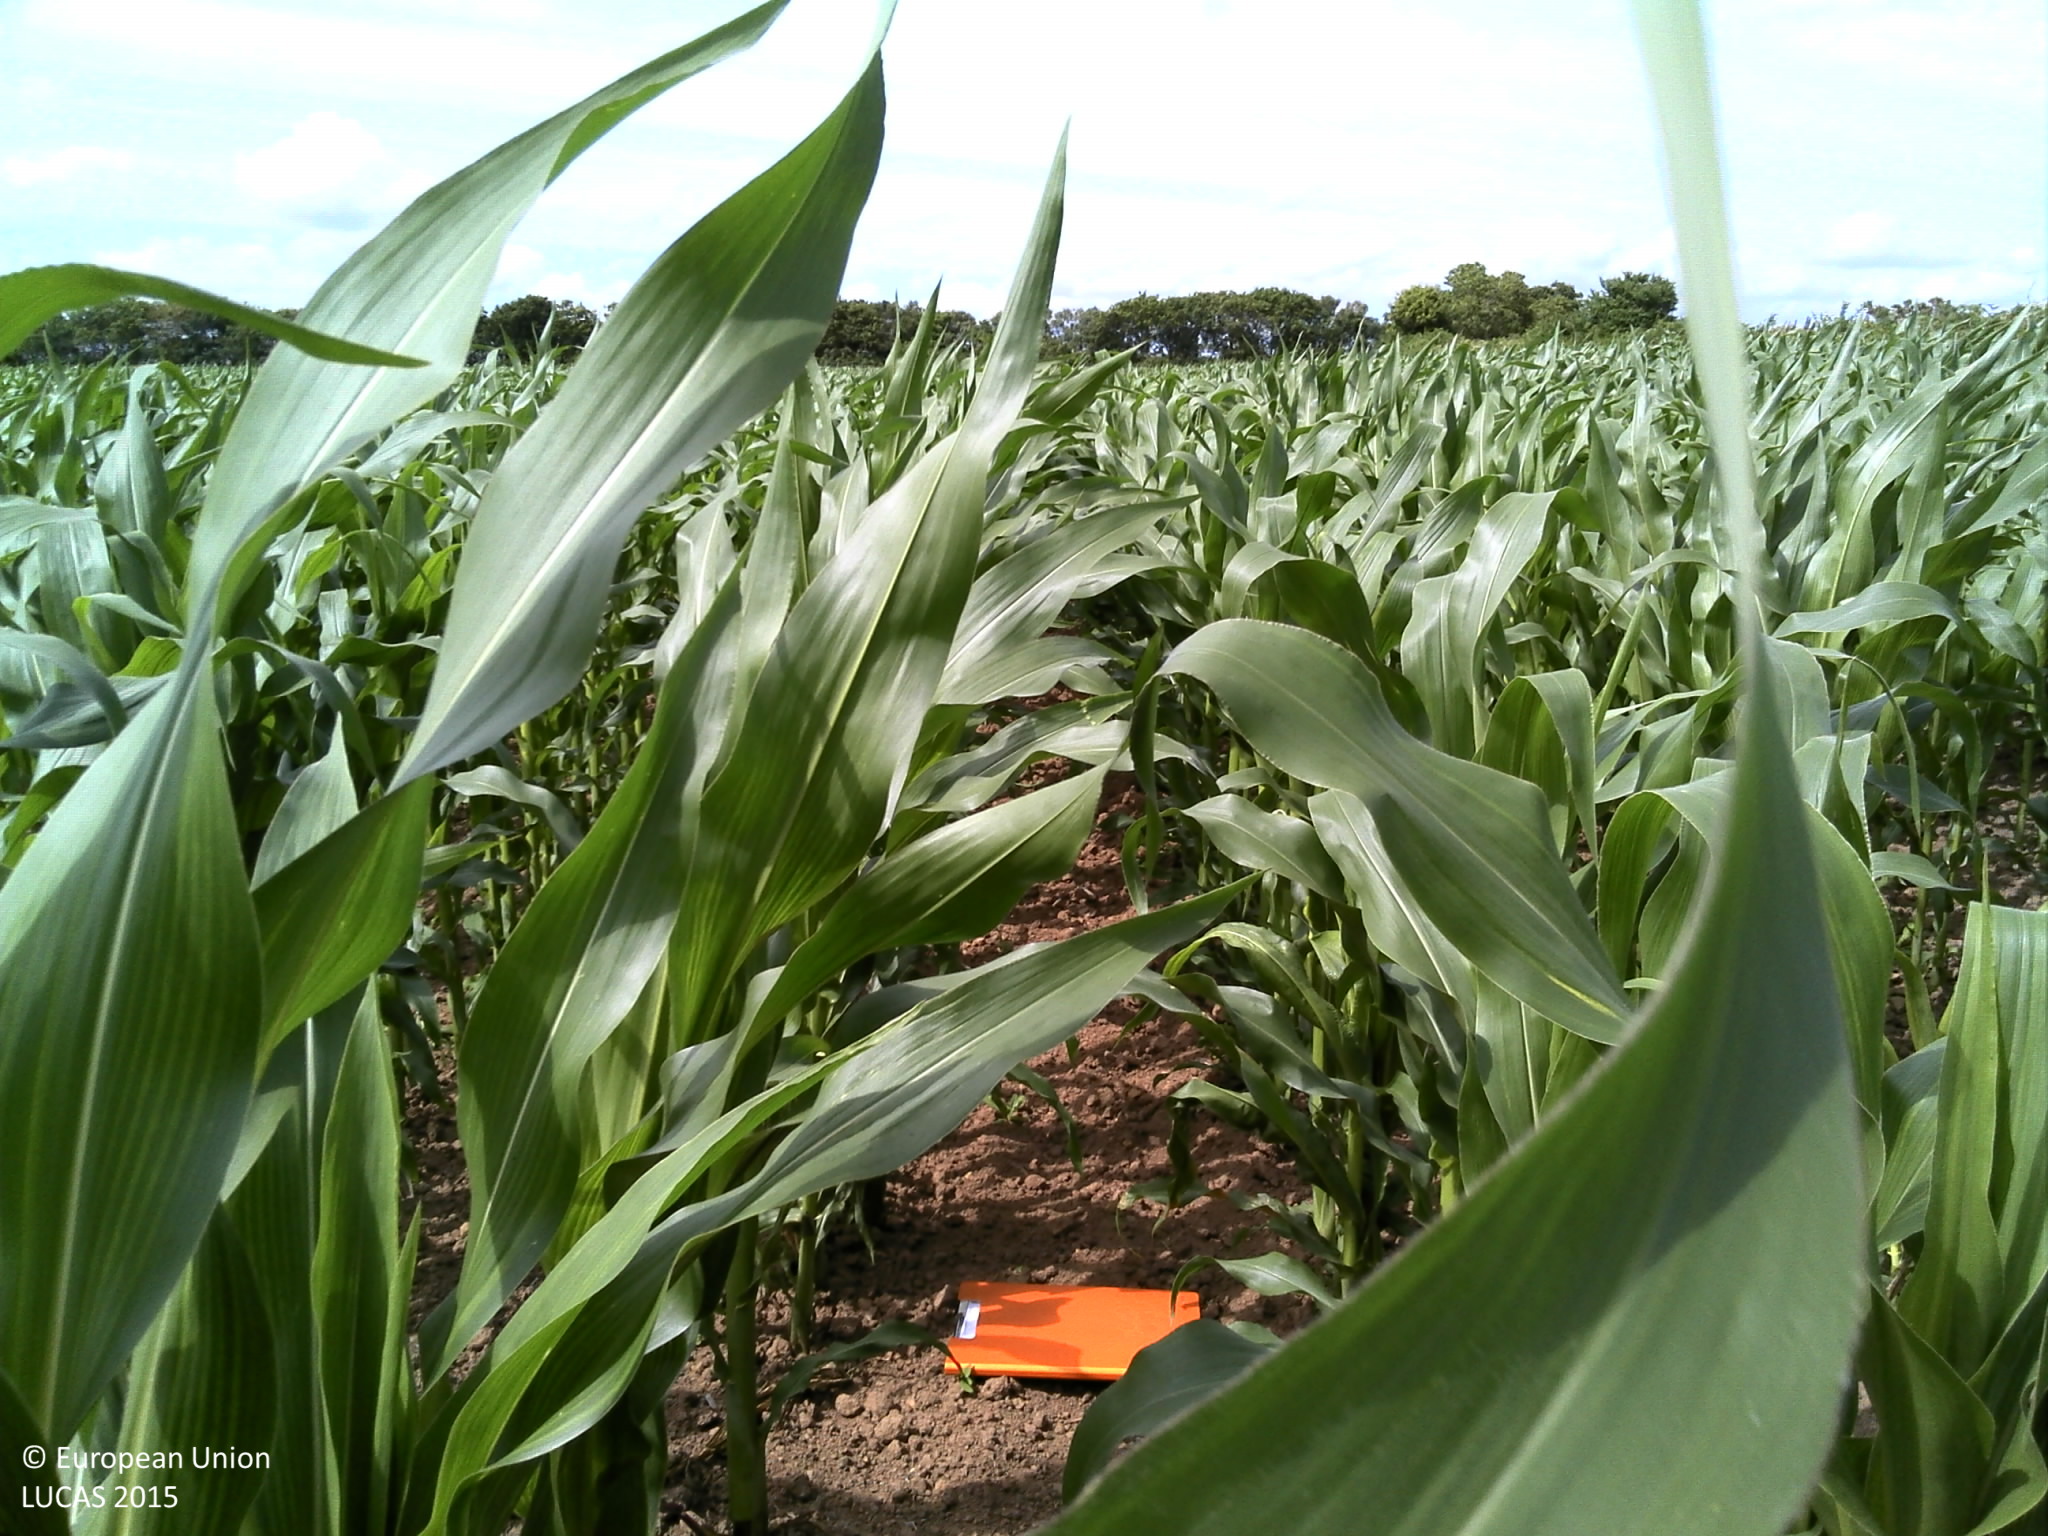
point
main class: Cropland
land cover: Maize
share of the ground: > 75 %
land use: Agriculture (excluding fallow land and kitchen gardens)
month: July
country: FR
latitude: 48.4539
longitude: -4.5821
